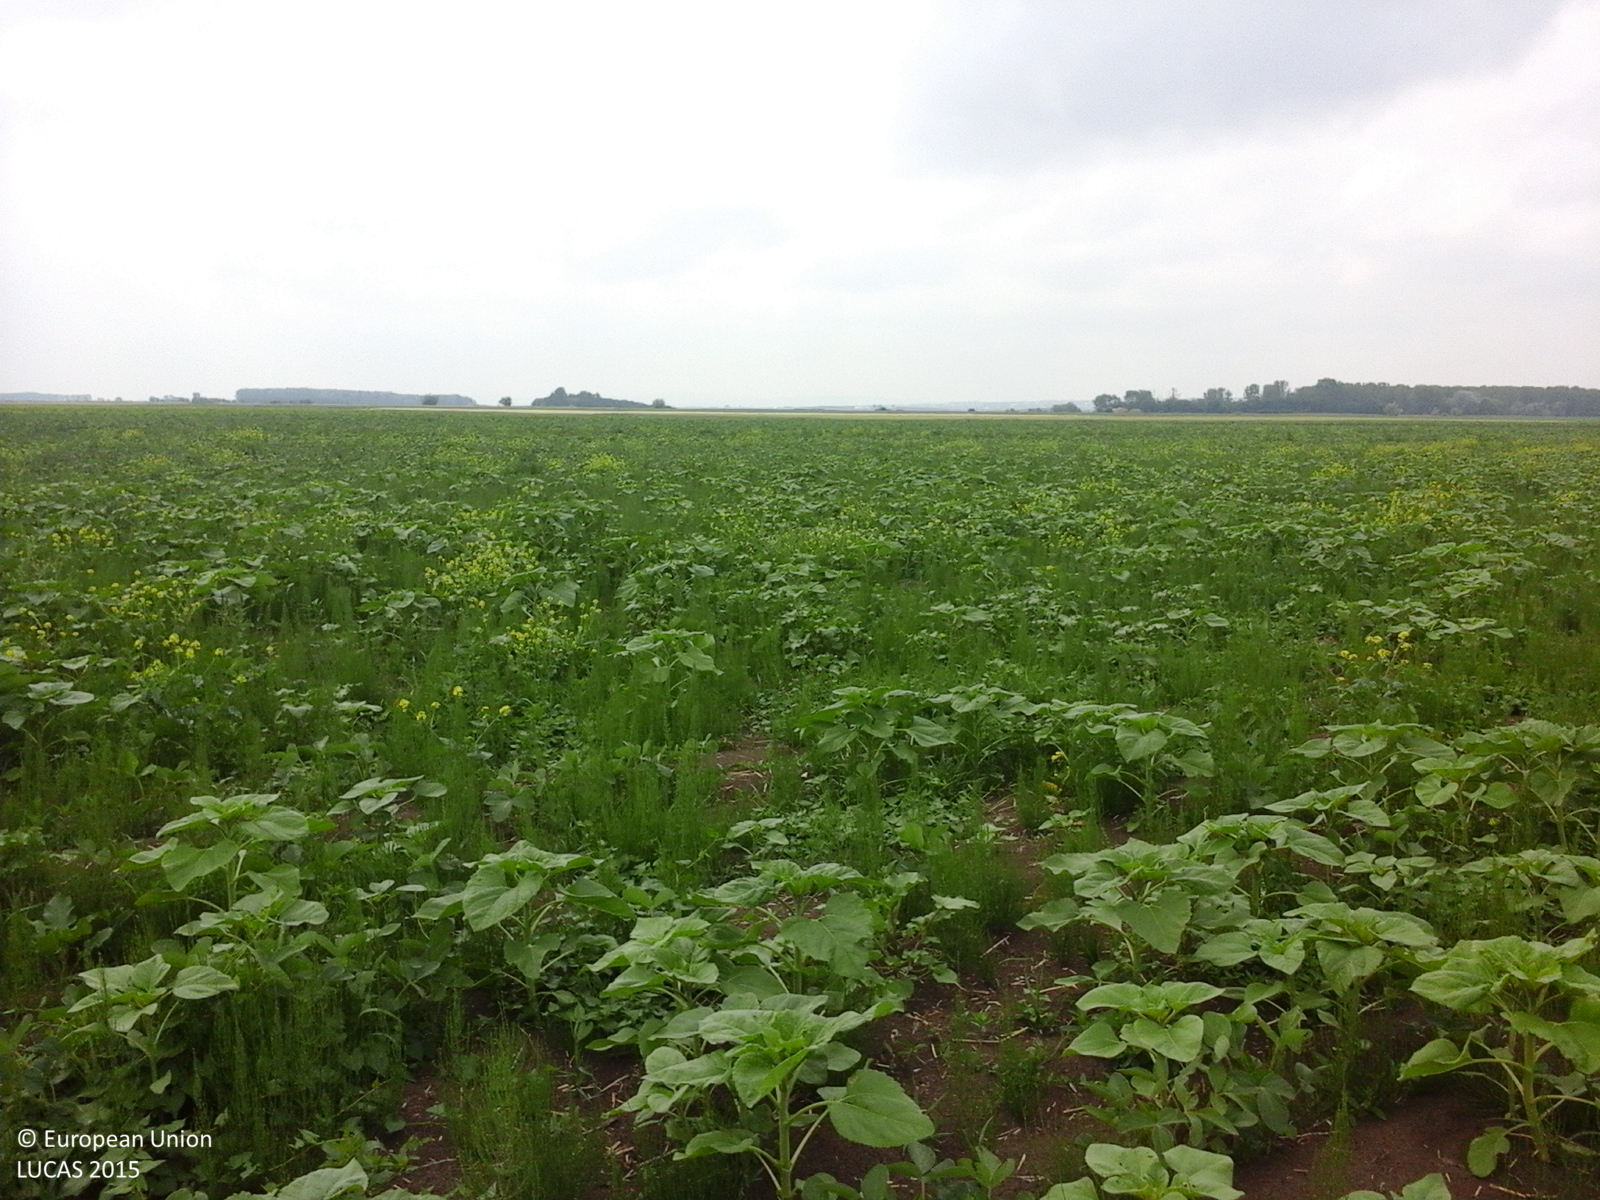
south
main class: Cropland
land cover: Sunflower
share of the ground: 25 - 50 %
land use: Agriculture (excluding fallow land and kitchen gardens)
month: June
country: RO
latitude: 47.7295
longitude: 26.4489
